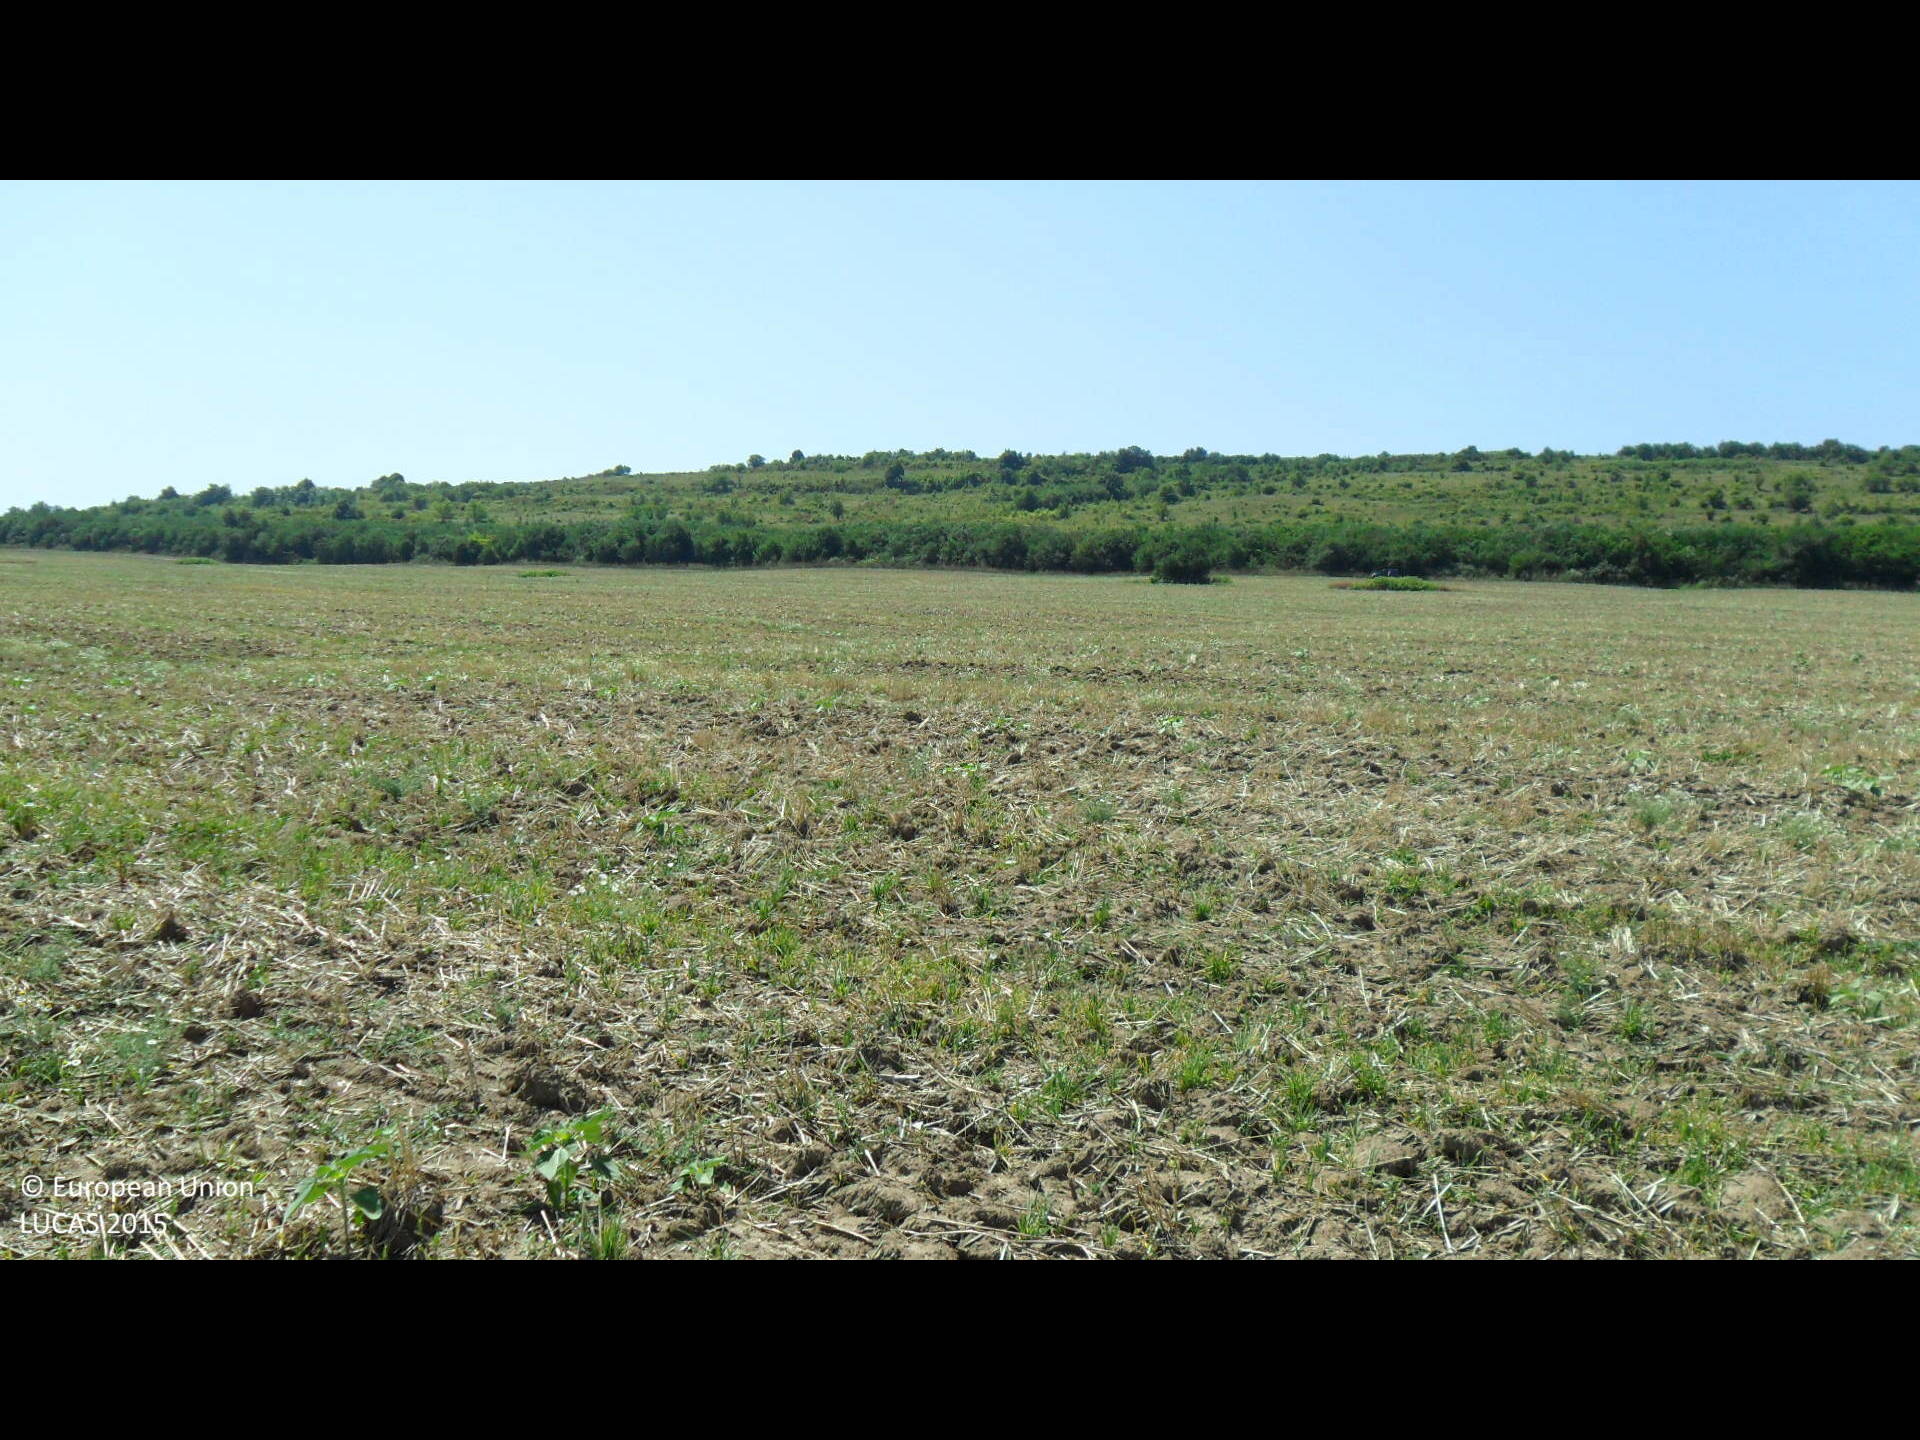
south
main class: Cropland
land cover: Barley
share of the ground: 10 - 25 %
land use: Agriculture (excluding fallow land and kitchen gardens)
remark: Harvested field
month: August
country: BG
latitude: 43.3341
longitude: 26.1403
